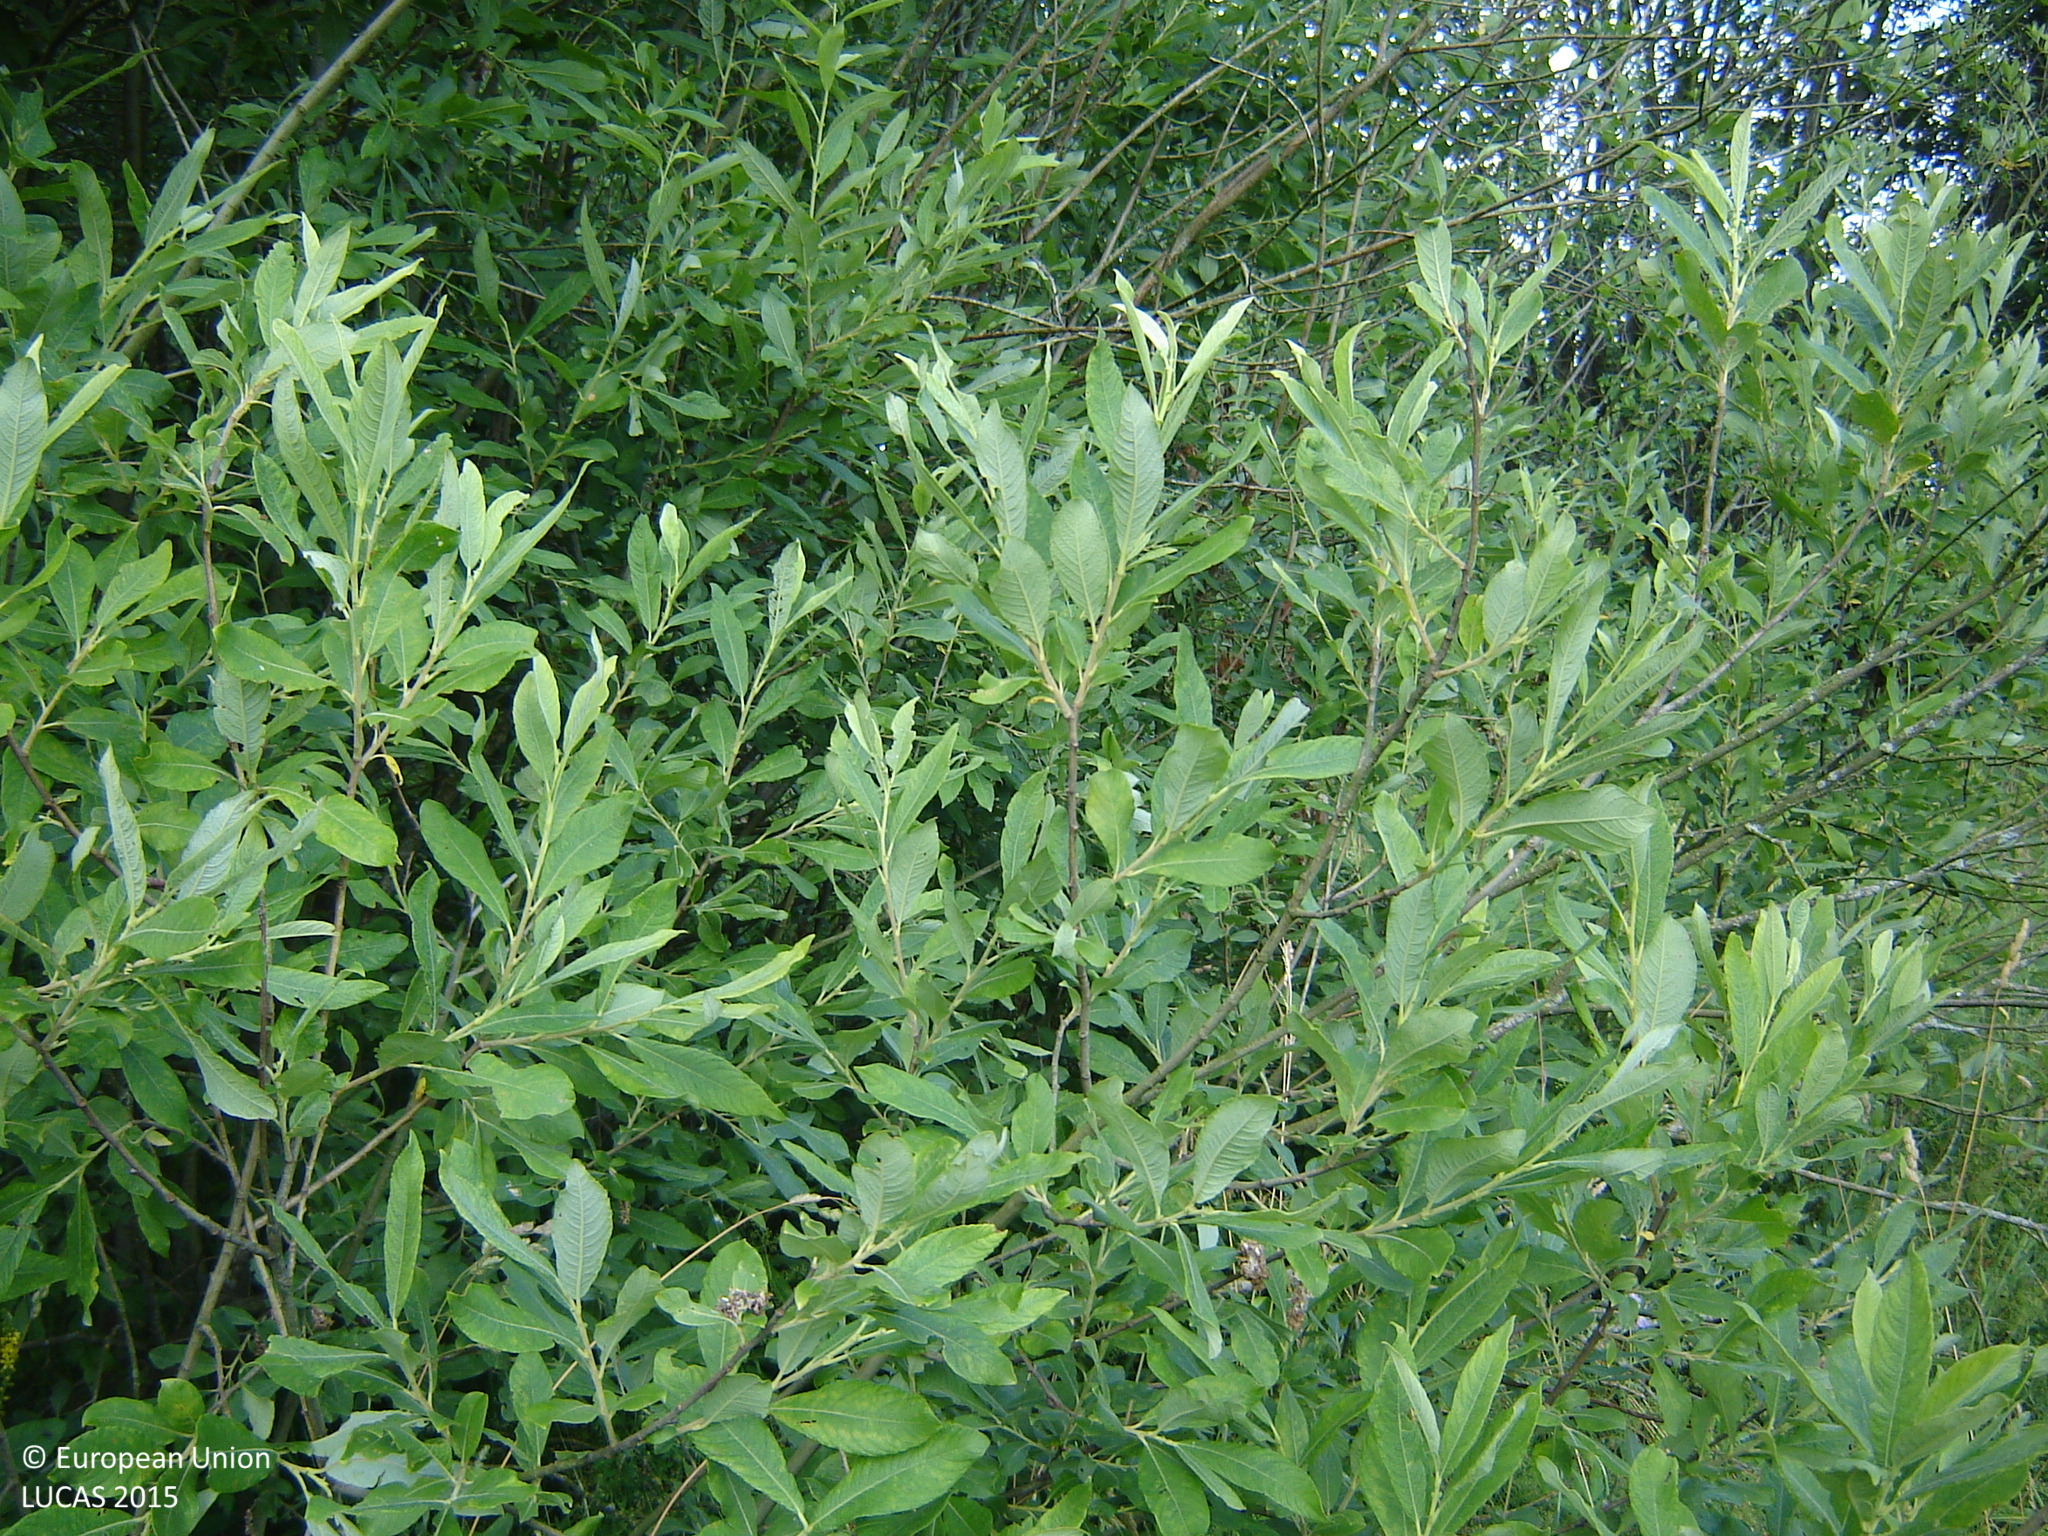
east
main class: Grassland
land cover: Grassland without tree/shrub cover
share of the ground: > 75 %
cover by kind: herbaceous plants 100 %
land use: Agriculture (excluding fallow land and kitchen gardens)
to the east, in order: Grassland without tree/shrub cover; Fences; Broadleaved woodland; Spontaneously vegetated surfaces; Grassland without tree/shrub cover
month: July
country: LT
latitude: 55.5018
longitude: 25.1393
